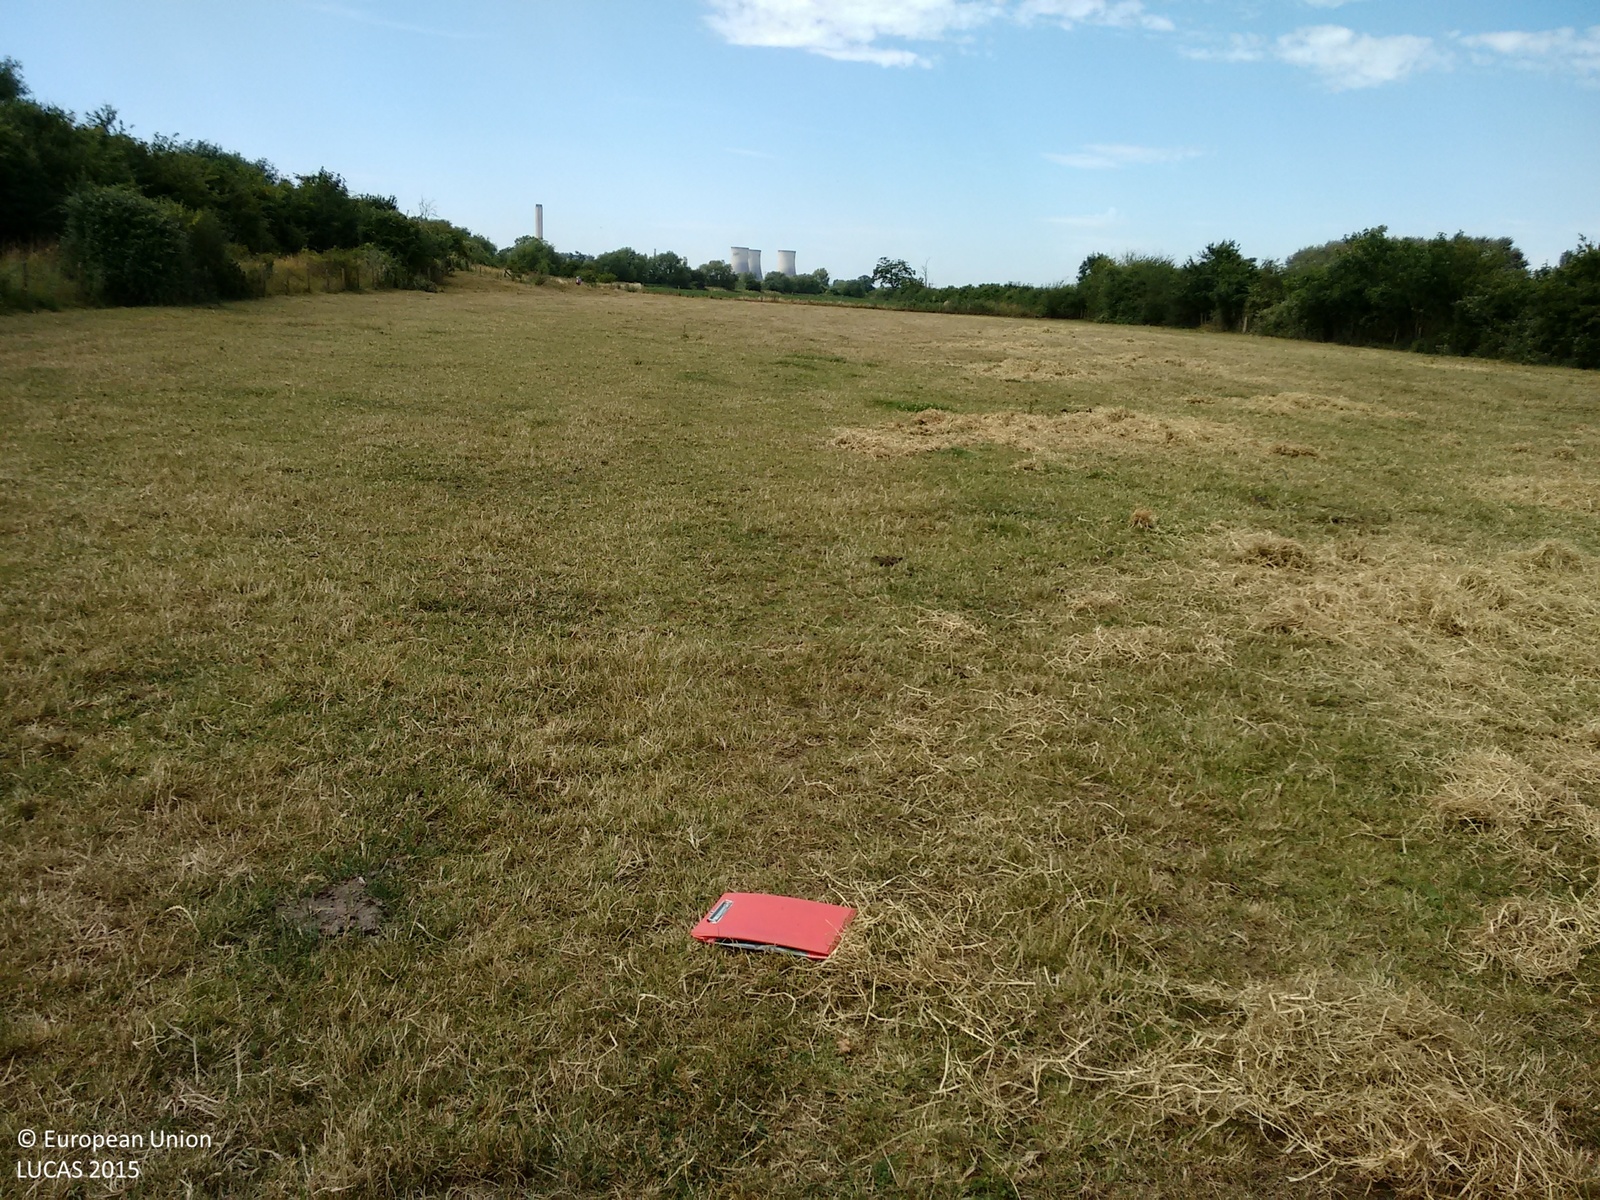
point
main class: Grassland
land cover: Grassland without tree/shrub cover
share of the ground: > 75 %
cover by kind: herbaceous plants 100 %
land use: Agriculture (excluding fallow land and kitchen gardens)
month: July
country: GB
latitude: 51.6441
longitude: -1.2181
